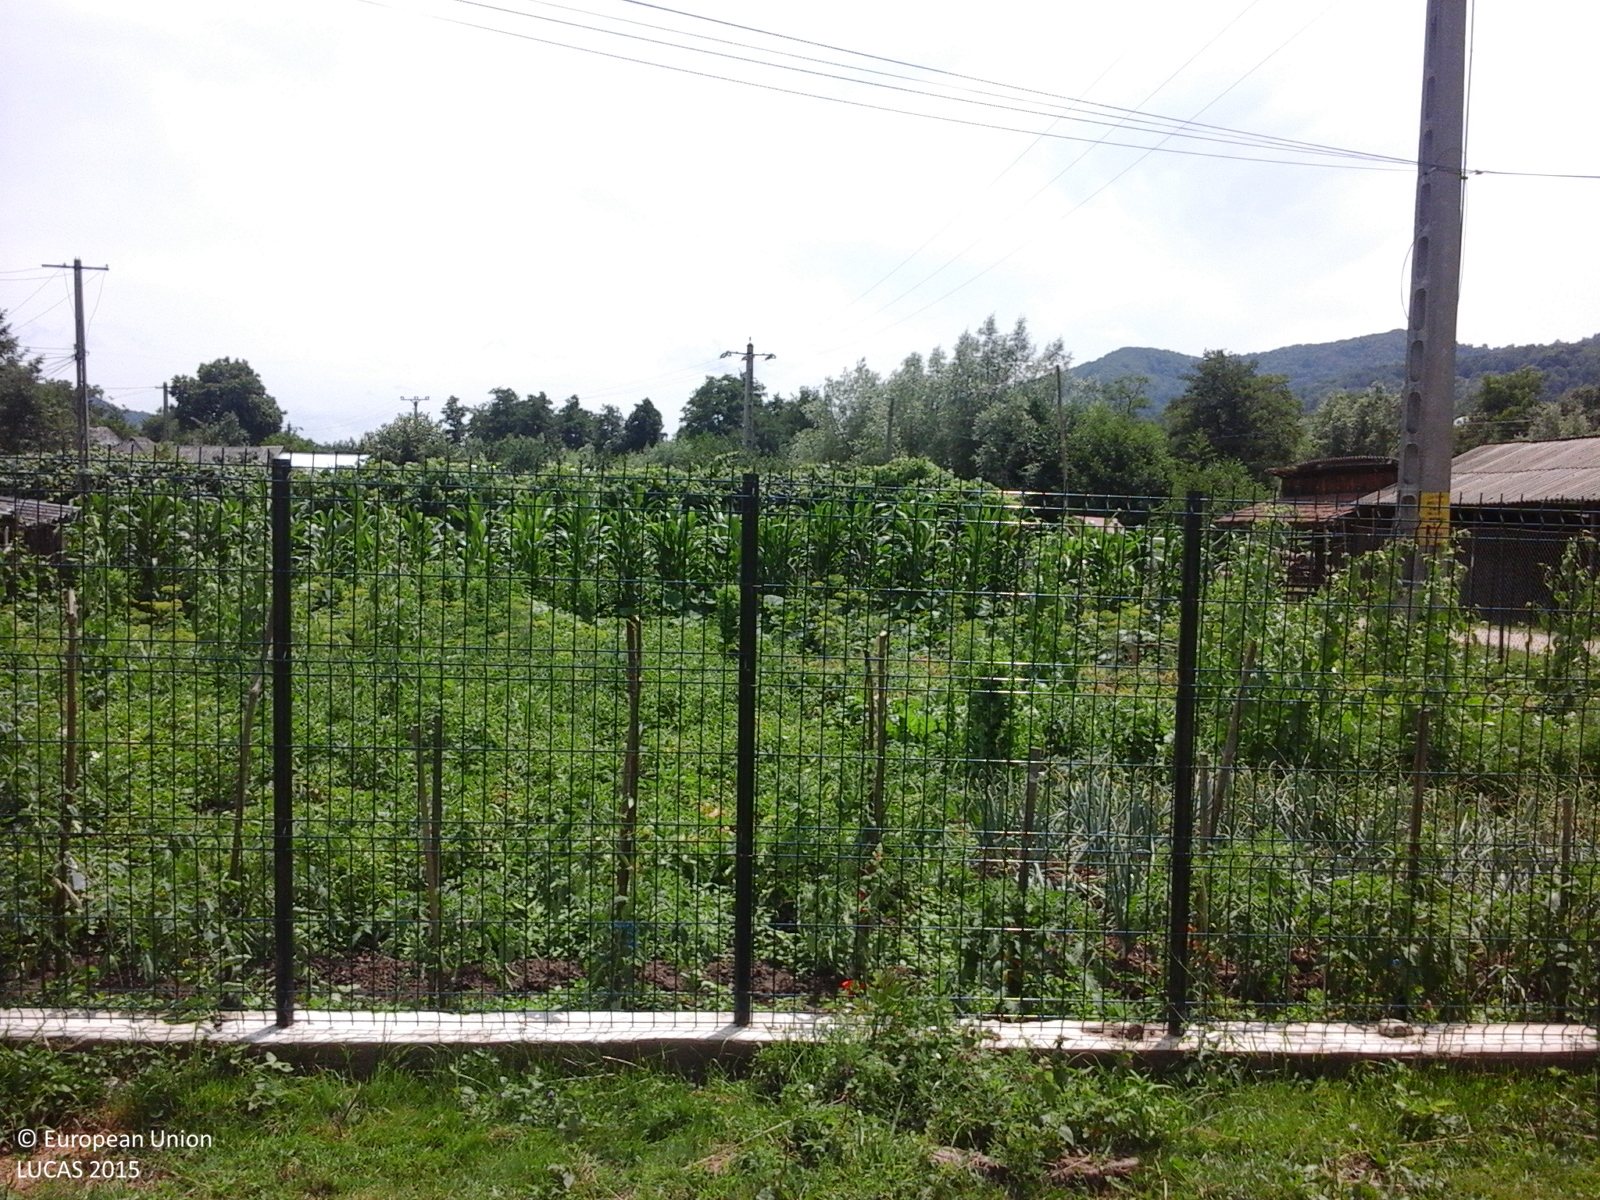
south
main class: Cropland
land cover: Potatoes
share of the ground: > 75 %
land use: Kitchen garden
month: July
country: RO
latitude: 45.2769
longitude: 24.8072
